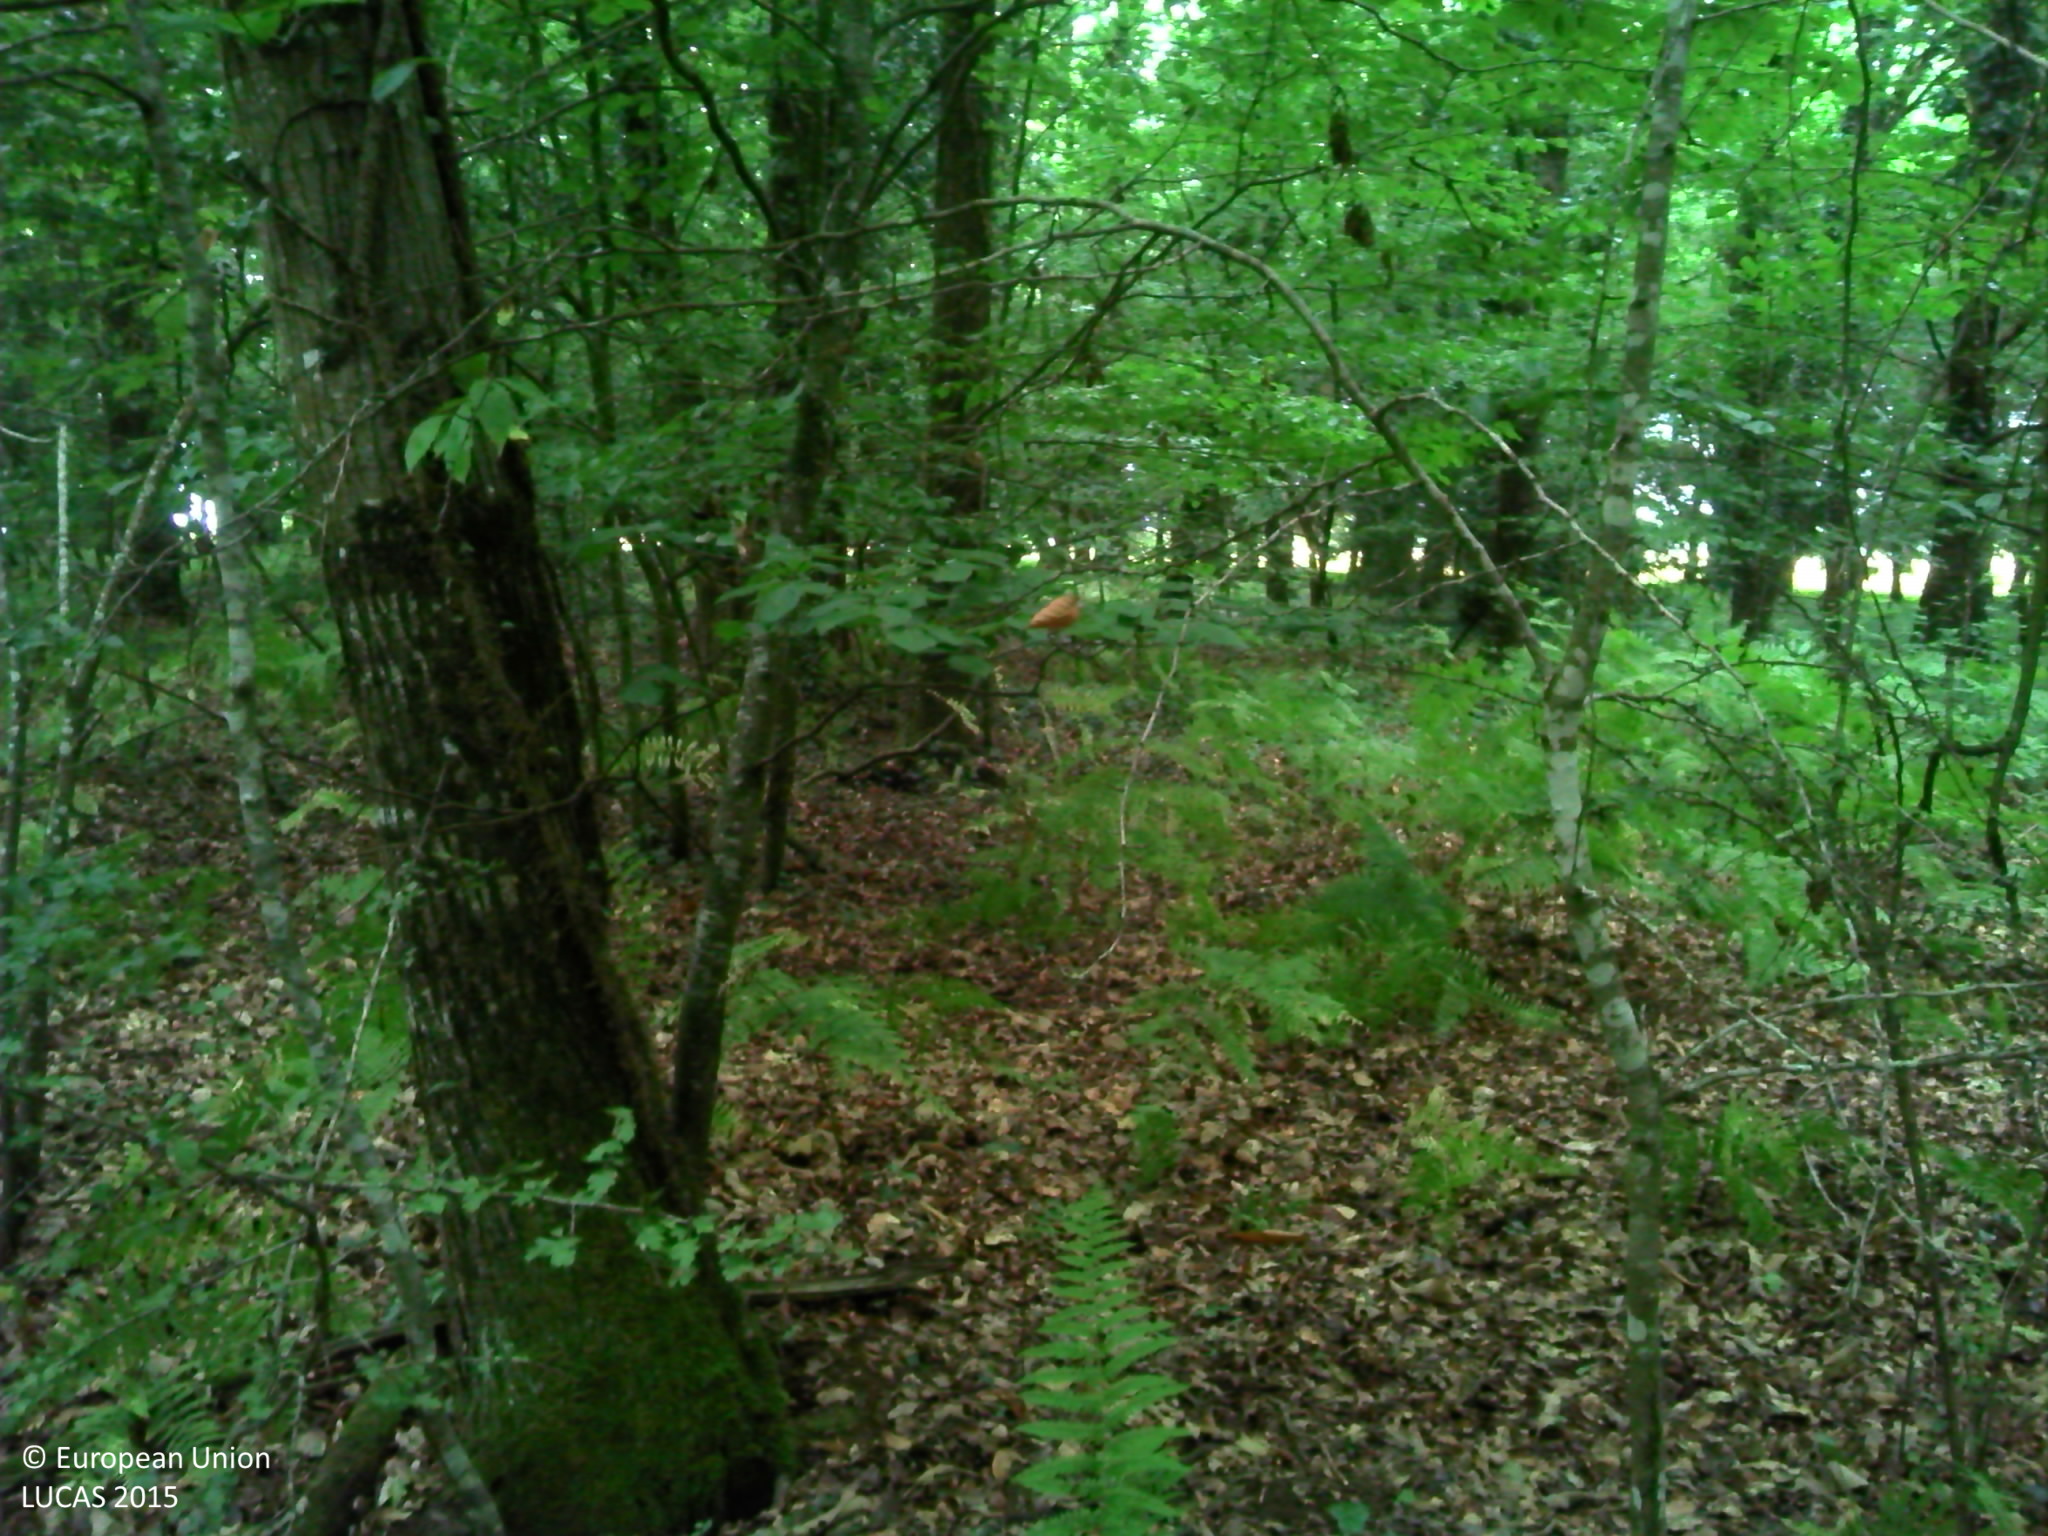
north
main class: Woodland
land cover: Broadleaved woodland
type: mesophytic deciduous forest
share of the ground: > 75 %
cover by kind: broadleaved forest trees 80 %, herbaceous plants 15 %, lichens and mosses 5 %
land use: Forestry
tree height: > 5 m
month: July
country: FR
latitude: 47.8520
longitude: -2.0399
